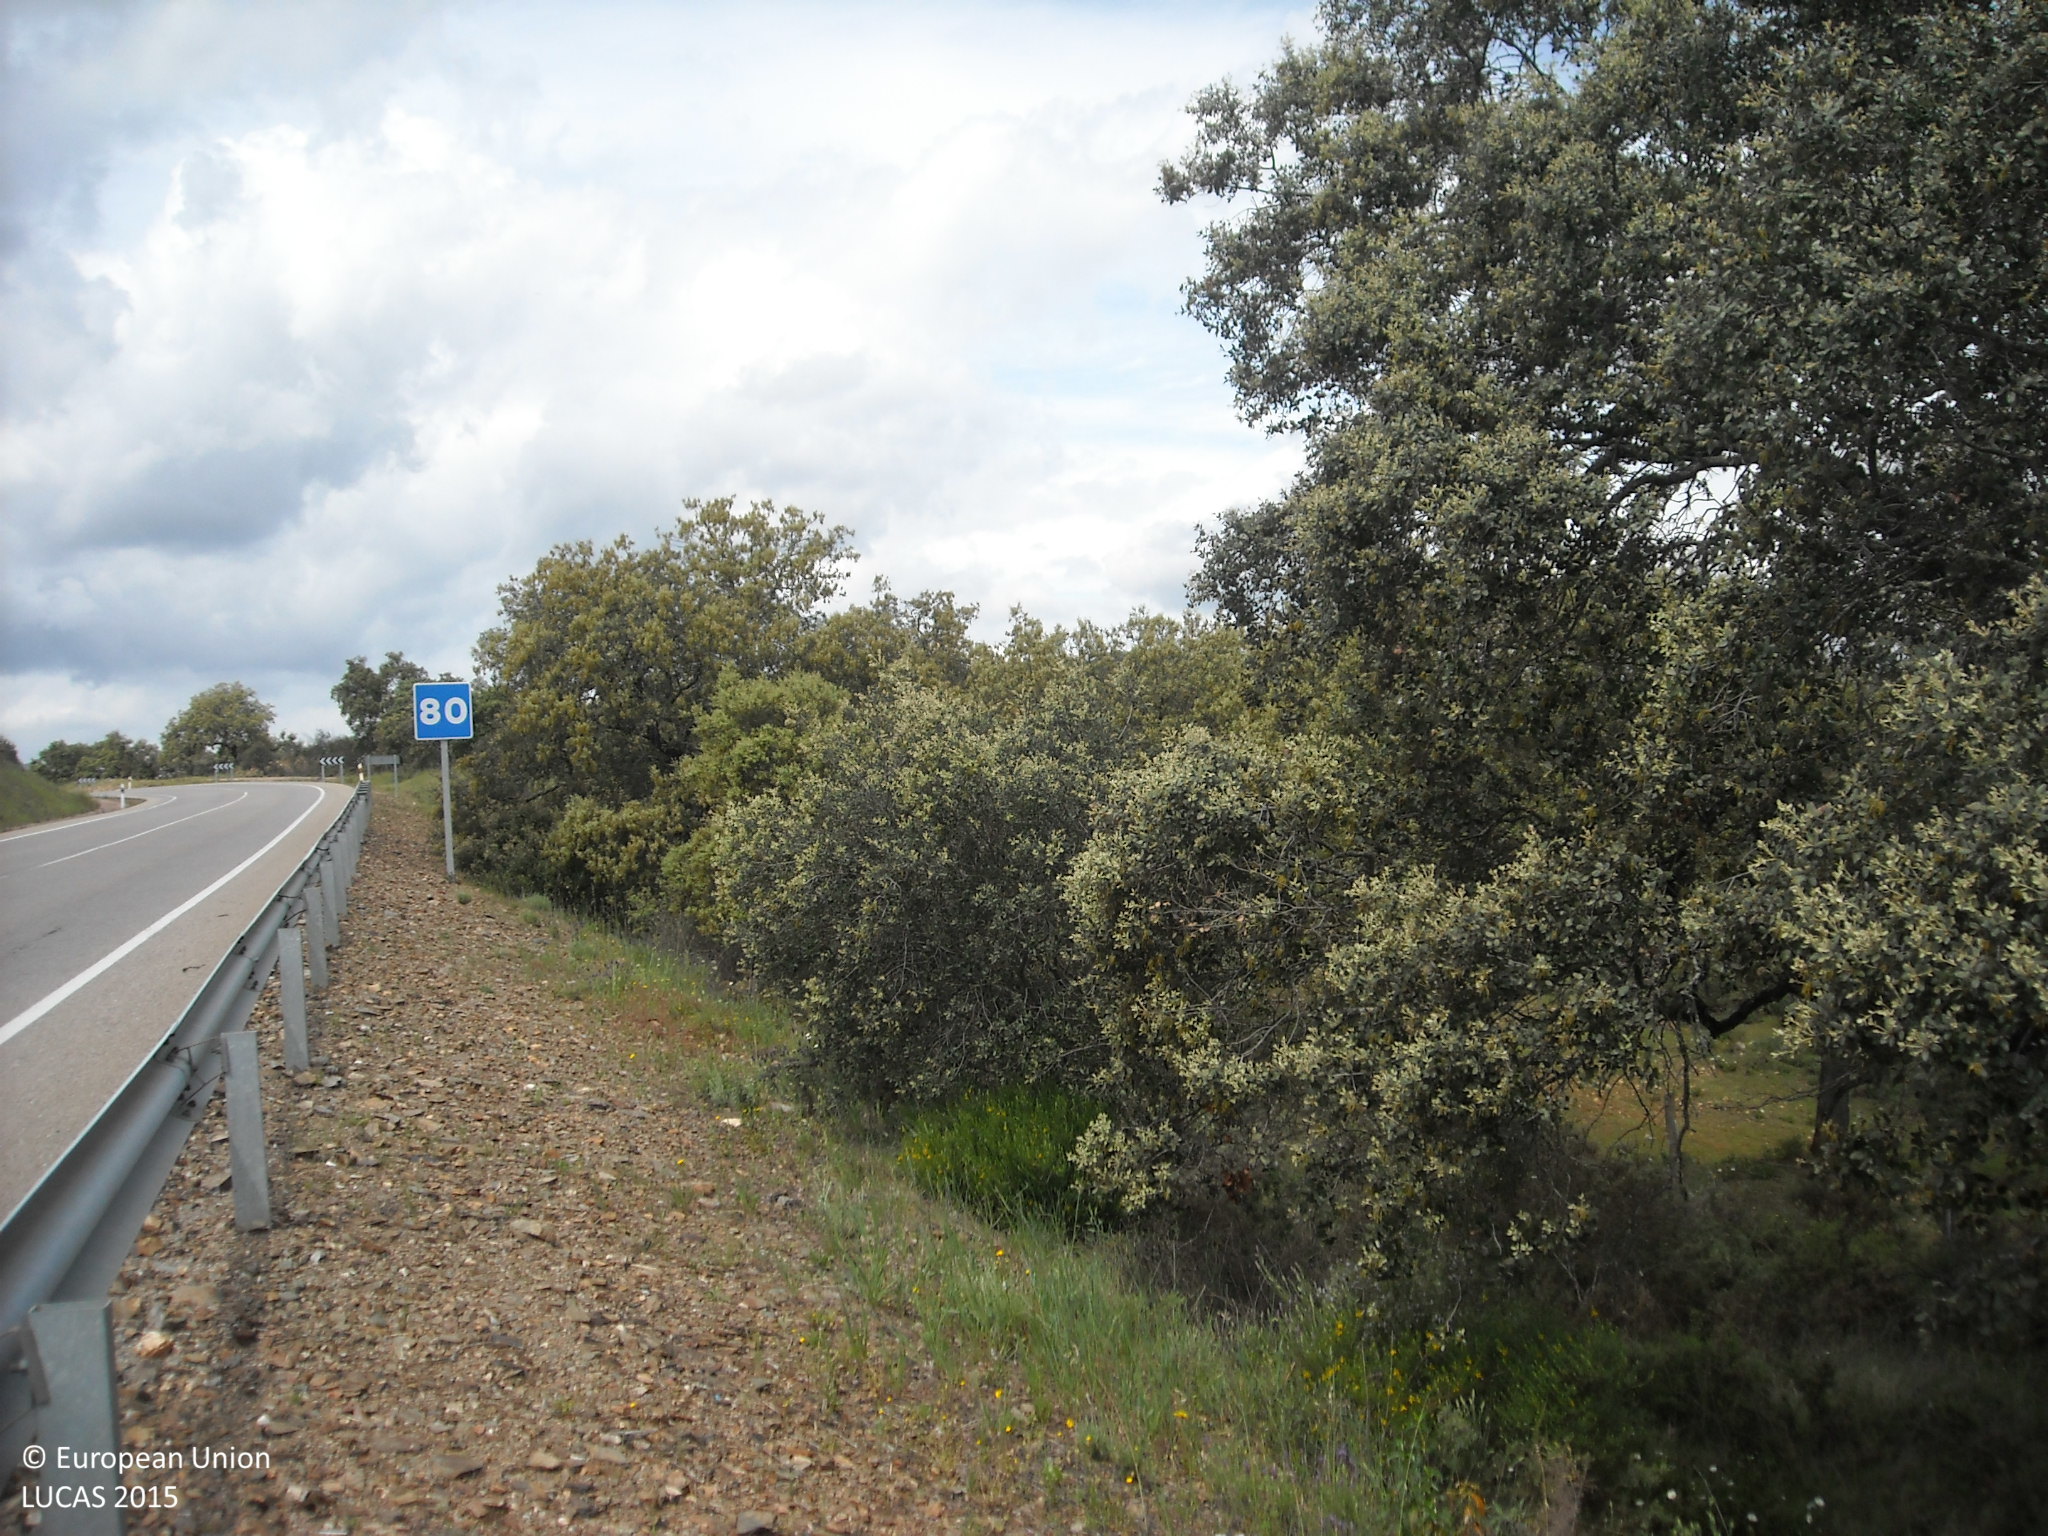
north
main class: Woodland
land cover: Broadleaved woodland
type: broadleaved evergreen forest
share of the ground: 10 - 25 %
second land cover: Grassland without tree/shrub cover
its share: > 75 %
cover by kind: herbaceous plants 75 %, broadleaved forest trees 20 %, shrubs 5 %
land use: Forestry
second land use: Agriculture (excluding fallow land and kitchen gardens)
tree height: > 5 m
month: April
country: ES
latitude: 37.7890
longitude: -6.4016
